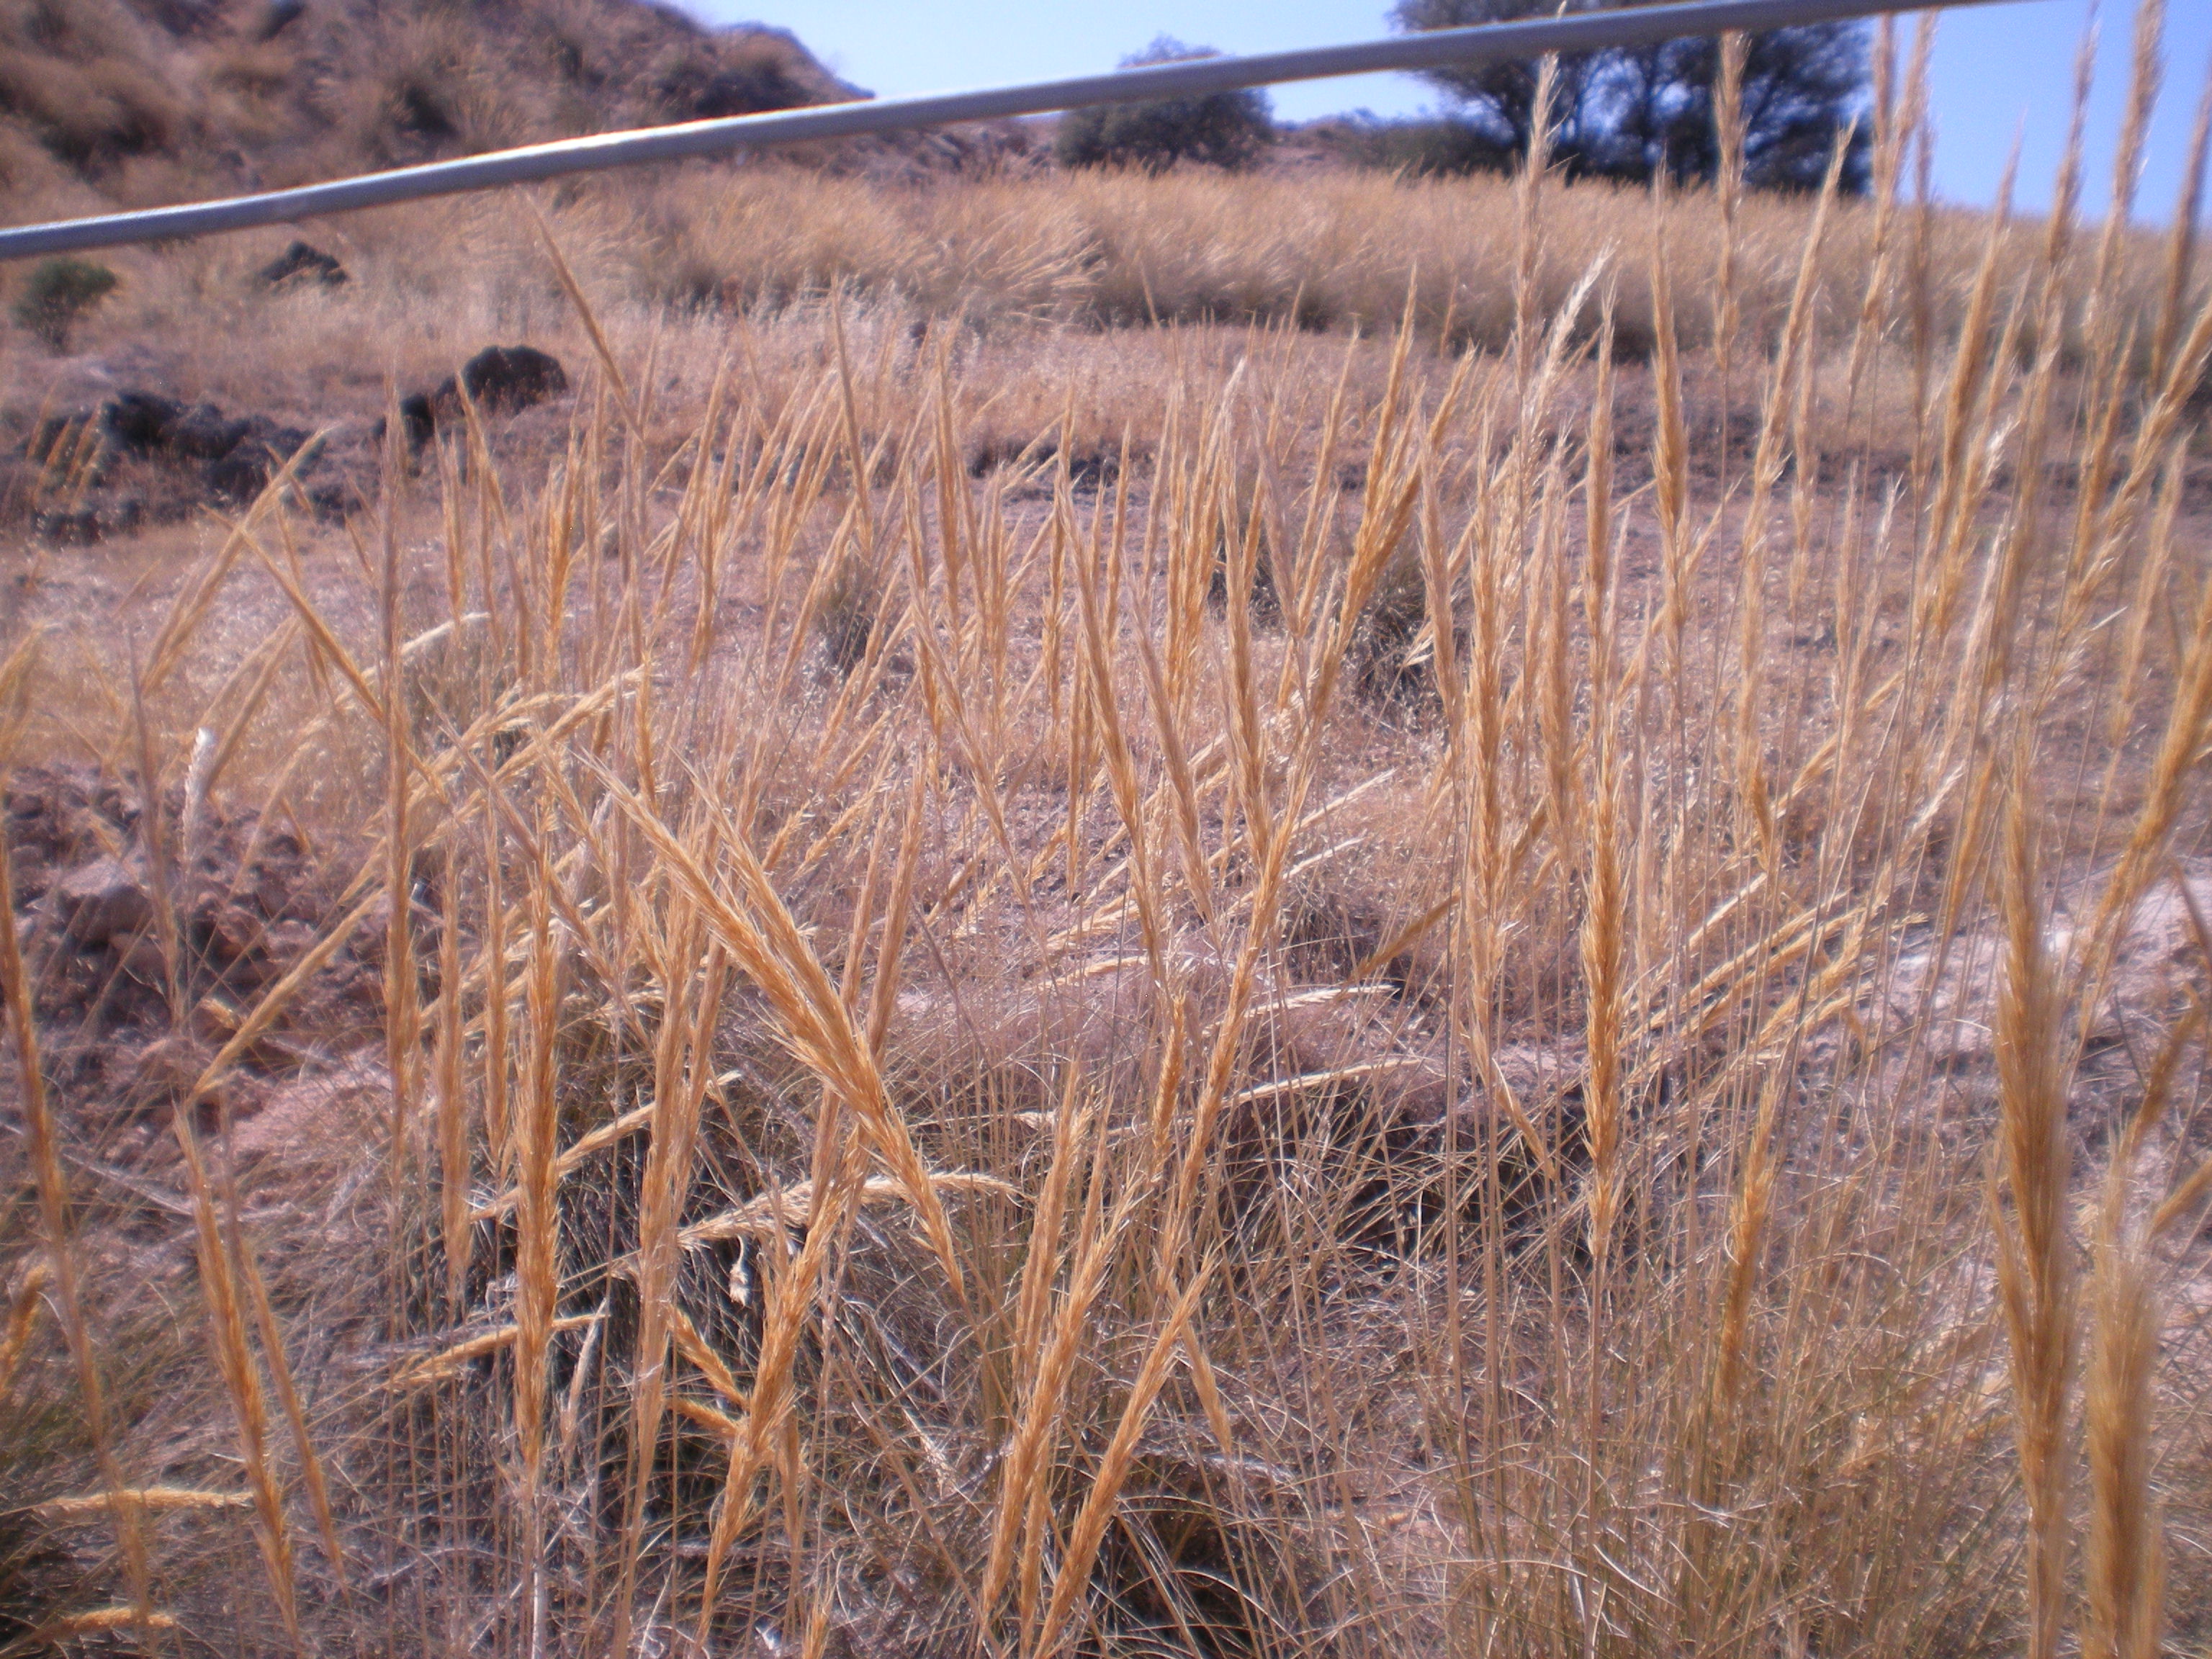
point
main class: Grassland
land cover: Grassland without tree/shrub cover
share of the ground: 25 - 50 %
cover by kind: unconsolidated bare surface 70 %, herbaceous plants 30 %
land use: Semi-natural and natural areas not in use
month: July
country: ES
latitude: 39.3667
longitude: -3.4963
